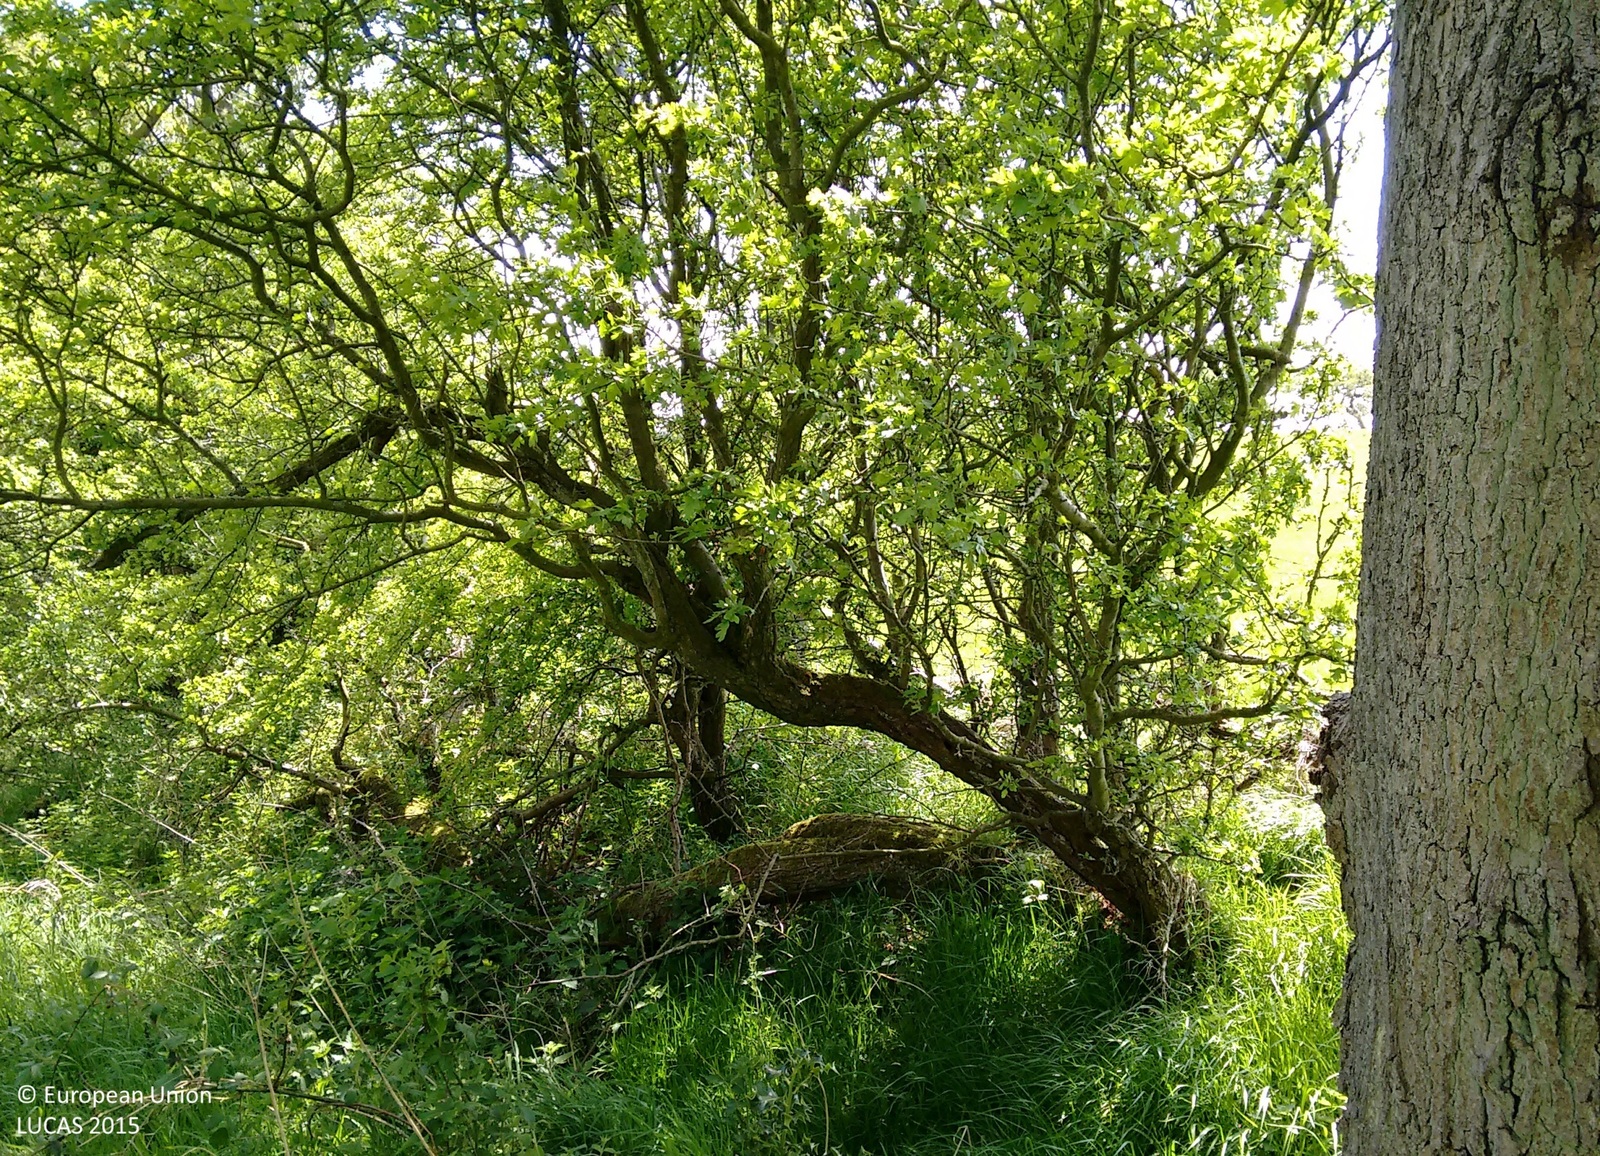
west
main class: Woodland
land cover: Broadleaved woodland
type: mesophytic deciduous forest
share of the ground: > 75 %
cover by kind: broadleaved forest trees 100 %
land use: Semi-natural and natural areas not in use
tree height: > 5 m
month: May
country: GB
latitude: 53.7943
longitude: -2.6217
